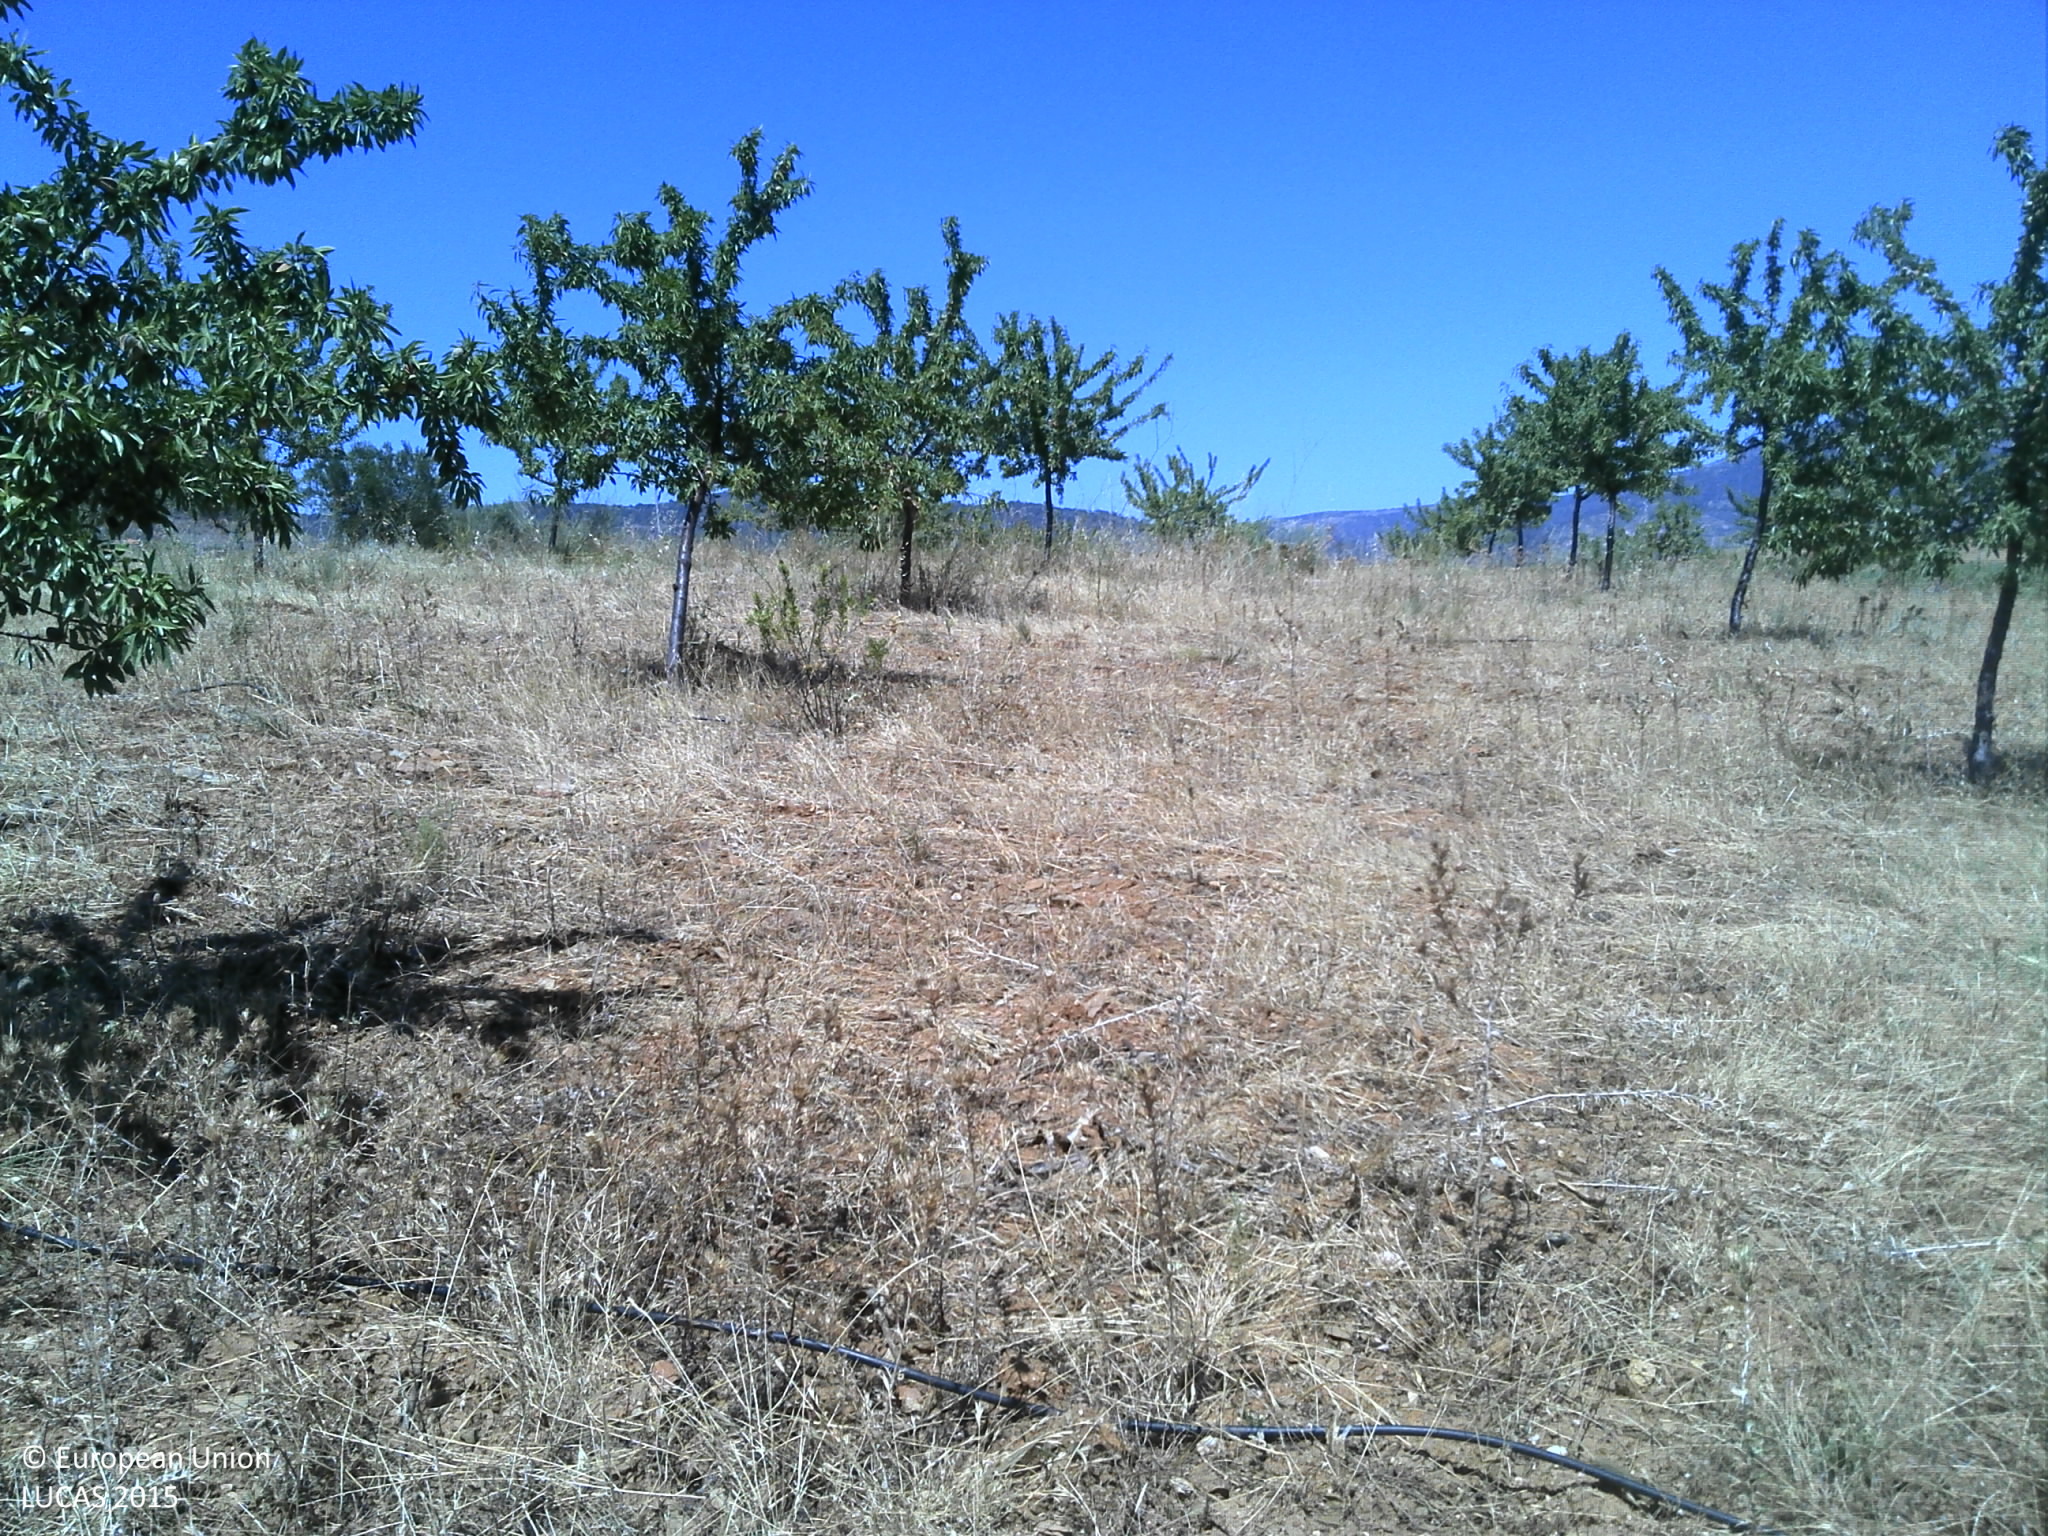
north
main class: Cropland
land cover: Nuts trees
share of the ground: < 10 %
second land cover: Grassland without tree/shrub cover
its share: > 75 %
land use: Agriculture (excluding fallow land and kitchen gardens)
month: July
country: PT
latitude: 41.3220
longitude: -7.0660
